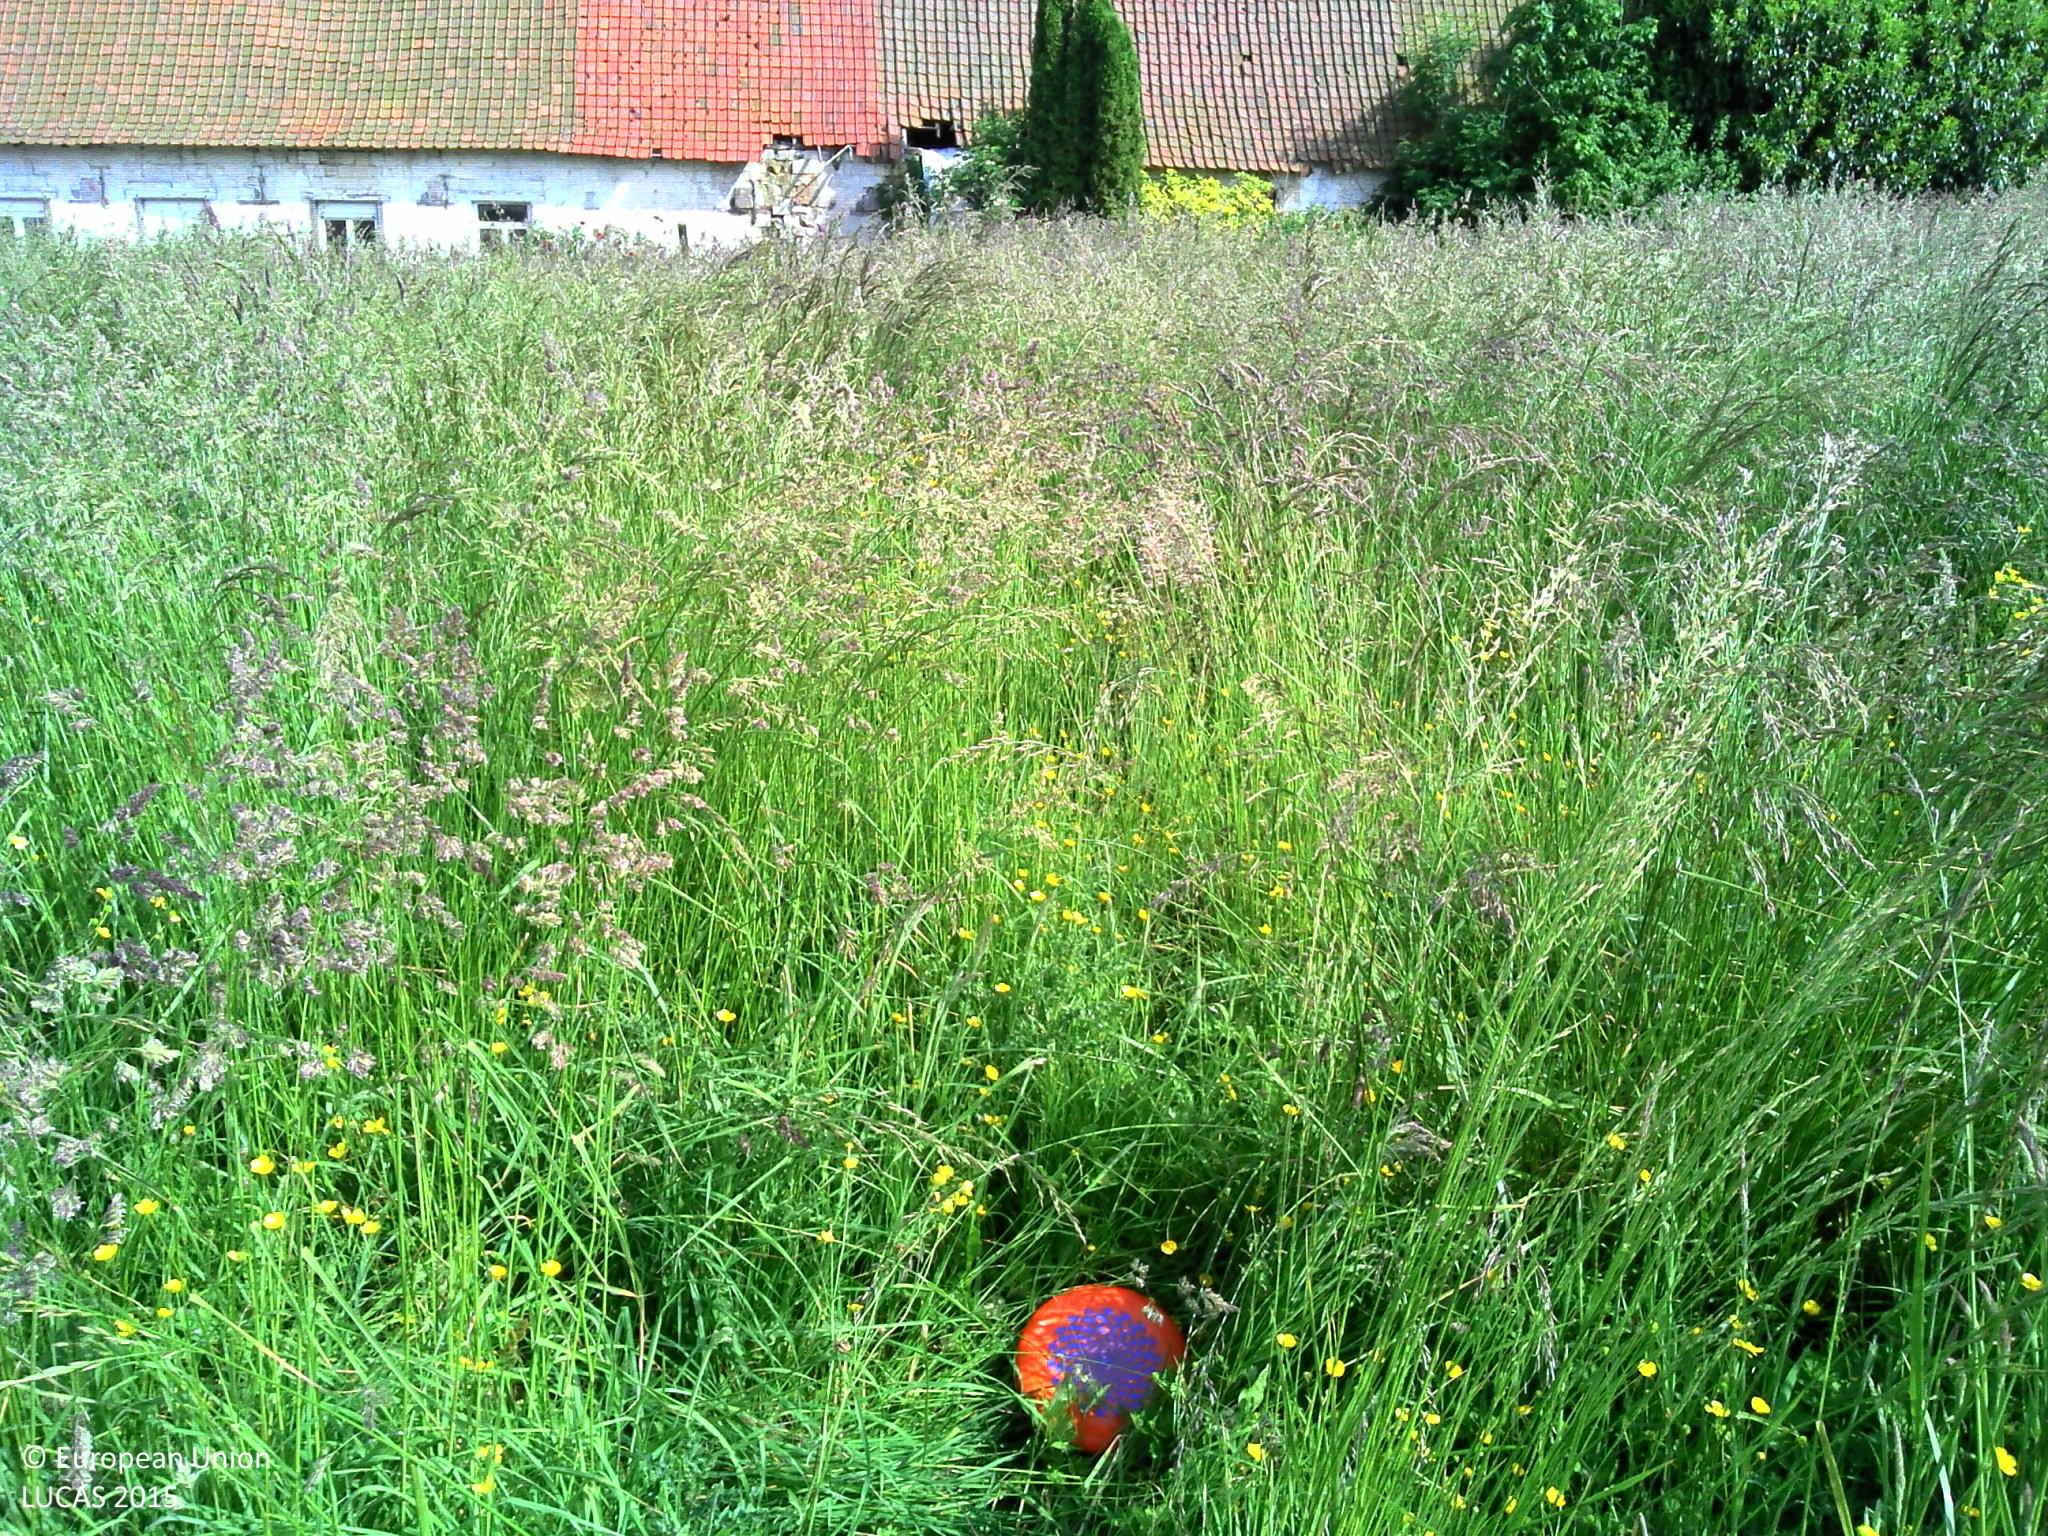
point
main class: Grassland
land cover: Grassland without tree/shrub cover
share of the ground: > 75 %
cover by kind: herbaceous plants 90 %
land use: Agriculture (excluding fallow land and kitchen gardens)
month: June
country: FR
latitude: 50.4341
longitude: 2.3700
